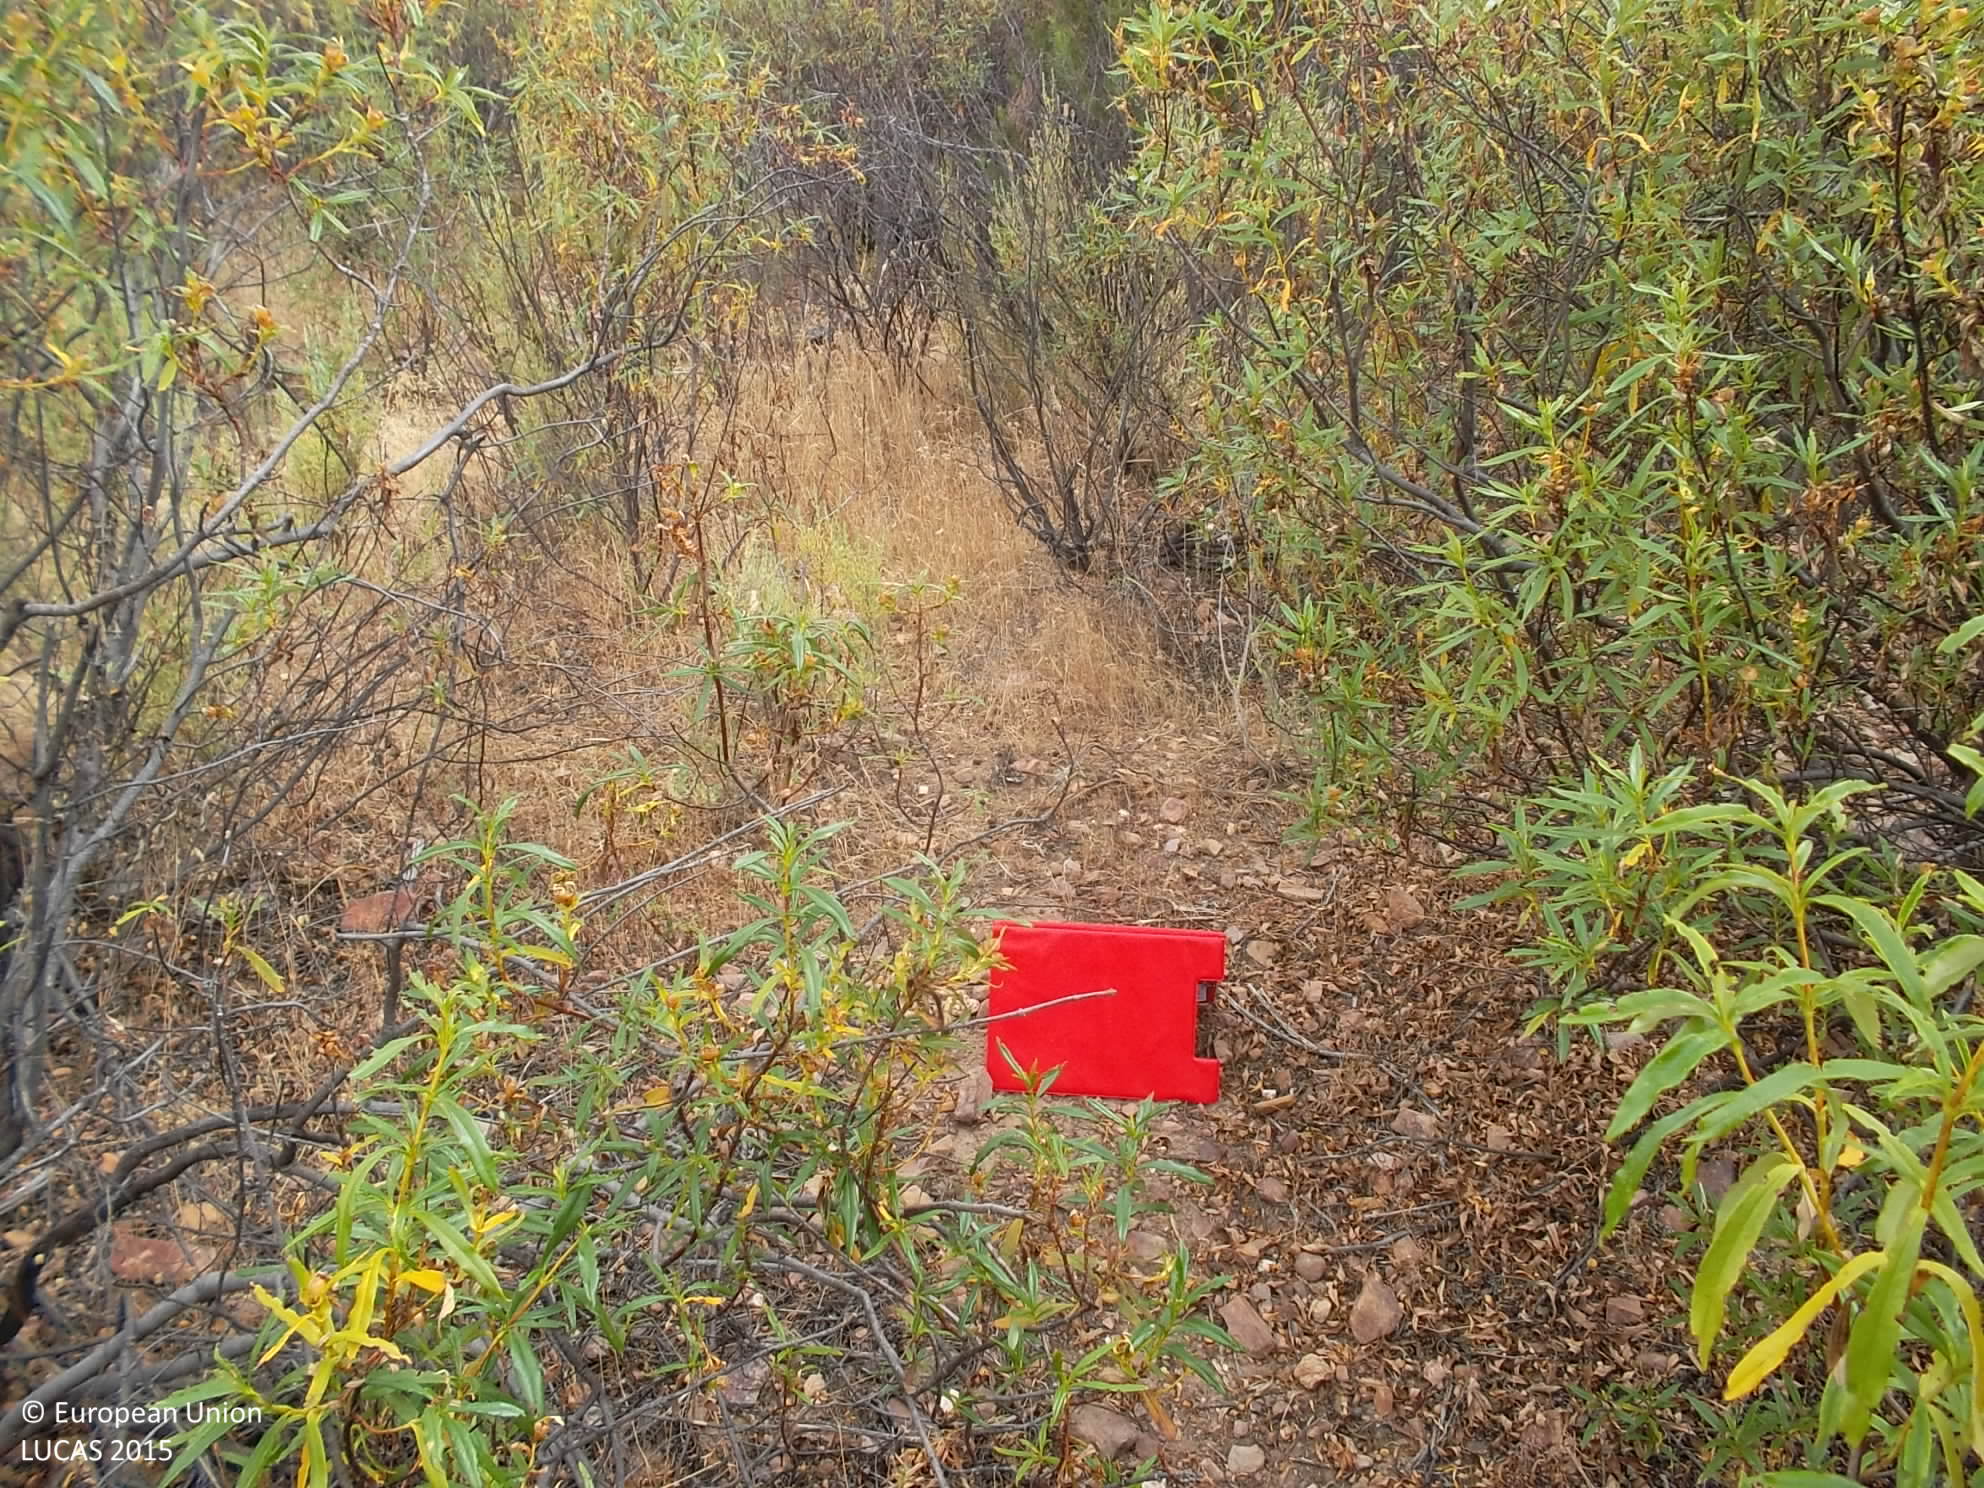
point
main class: Woodland
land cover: Broadleaved woodland
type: broadleaved evergreen forest
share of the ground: 50 - 75 %
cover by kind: shrubs 70 %, broadleaved forest trees 20 %, herbaceous plants 10 %
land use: Semi-natural and natural areas not in use
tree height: > 5 m
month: June
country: ES
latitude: 39.3459
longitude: -4.9979
